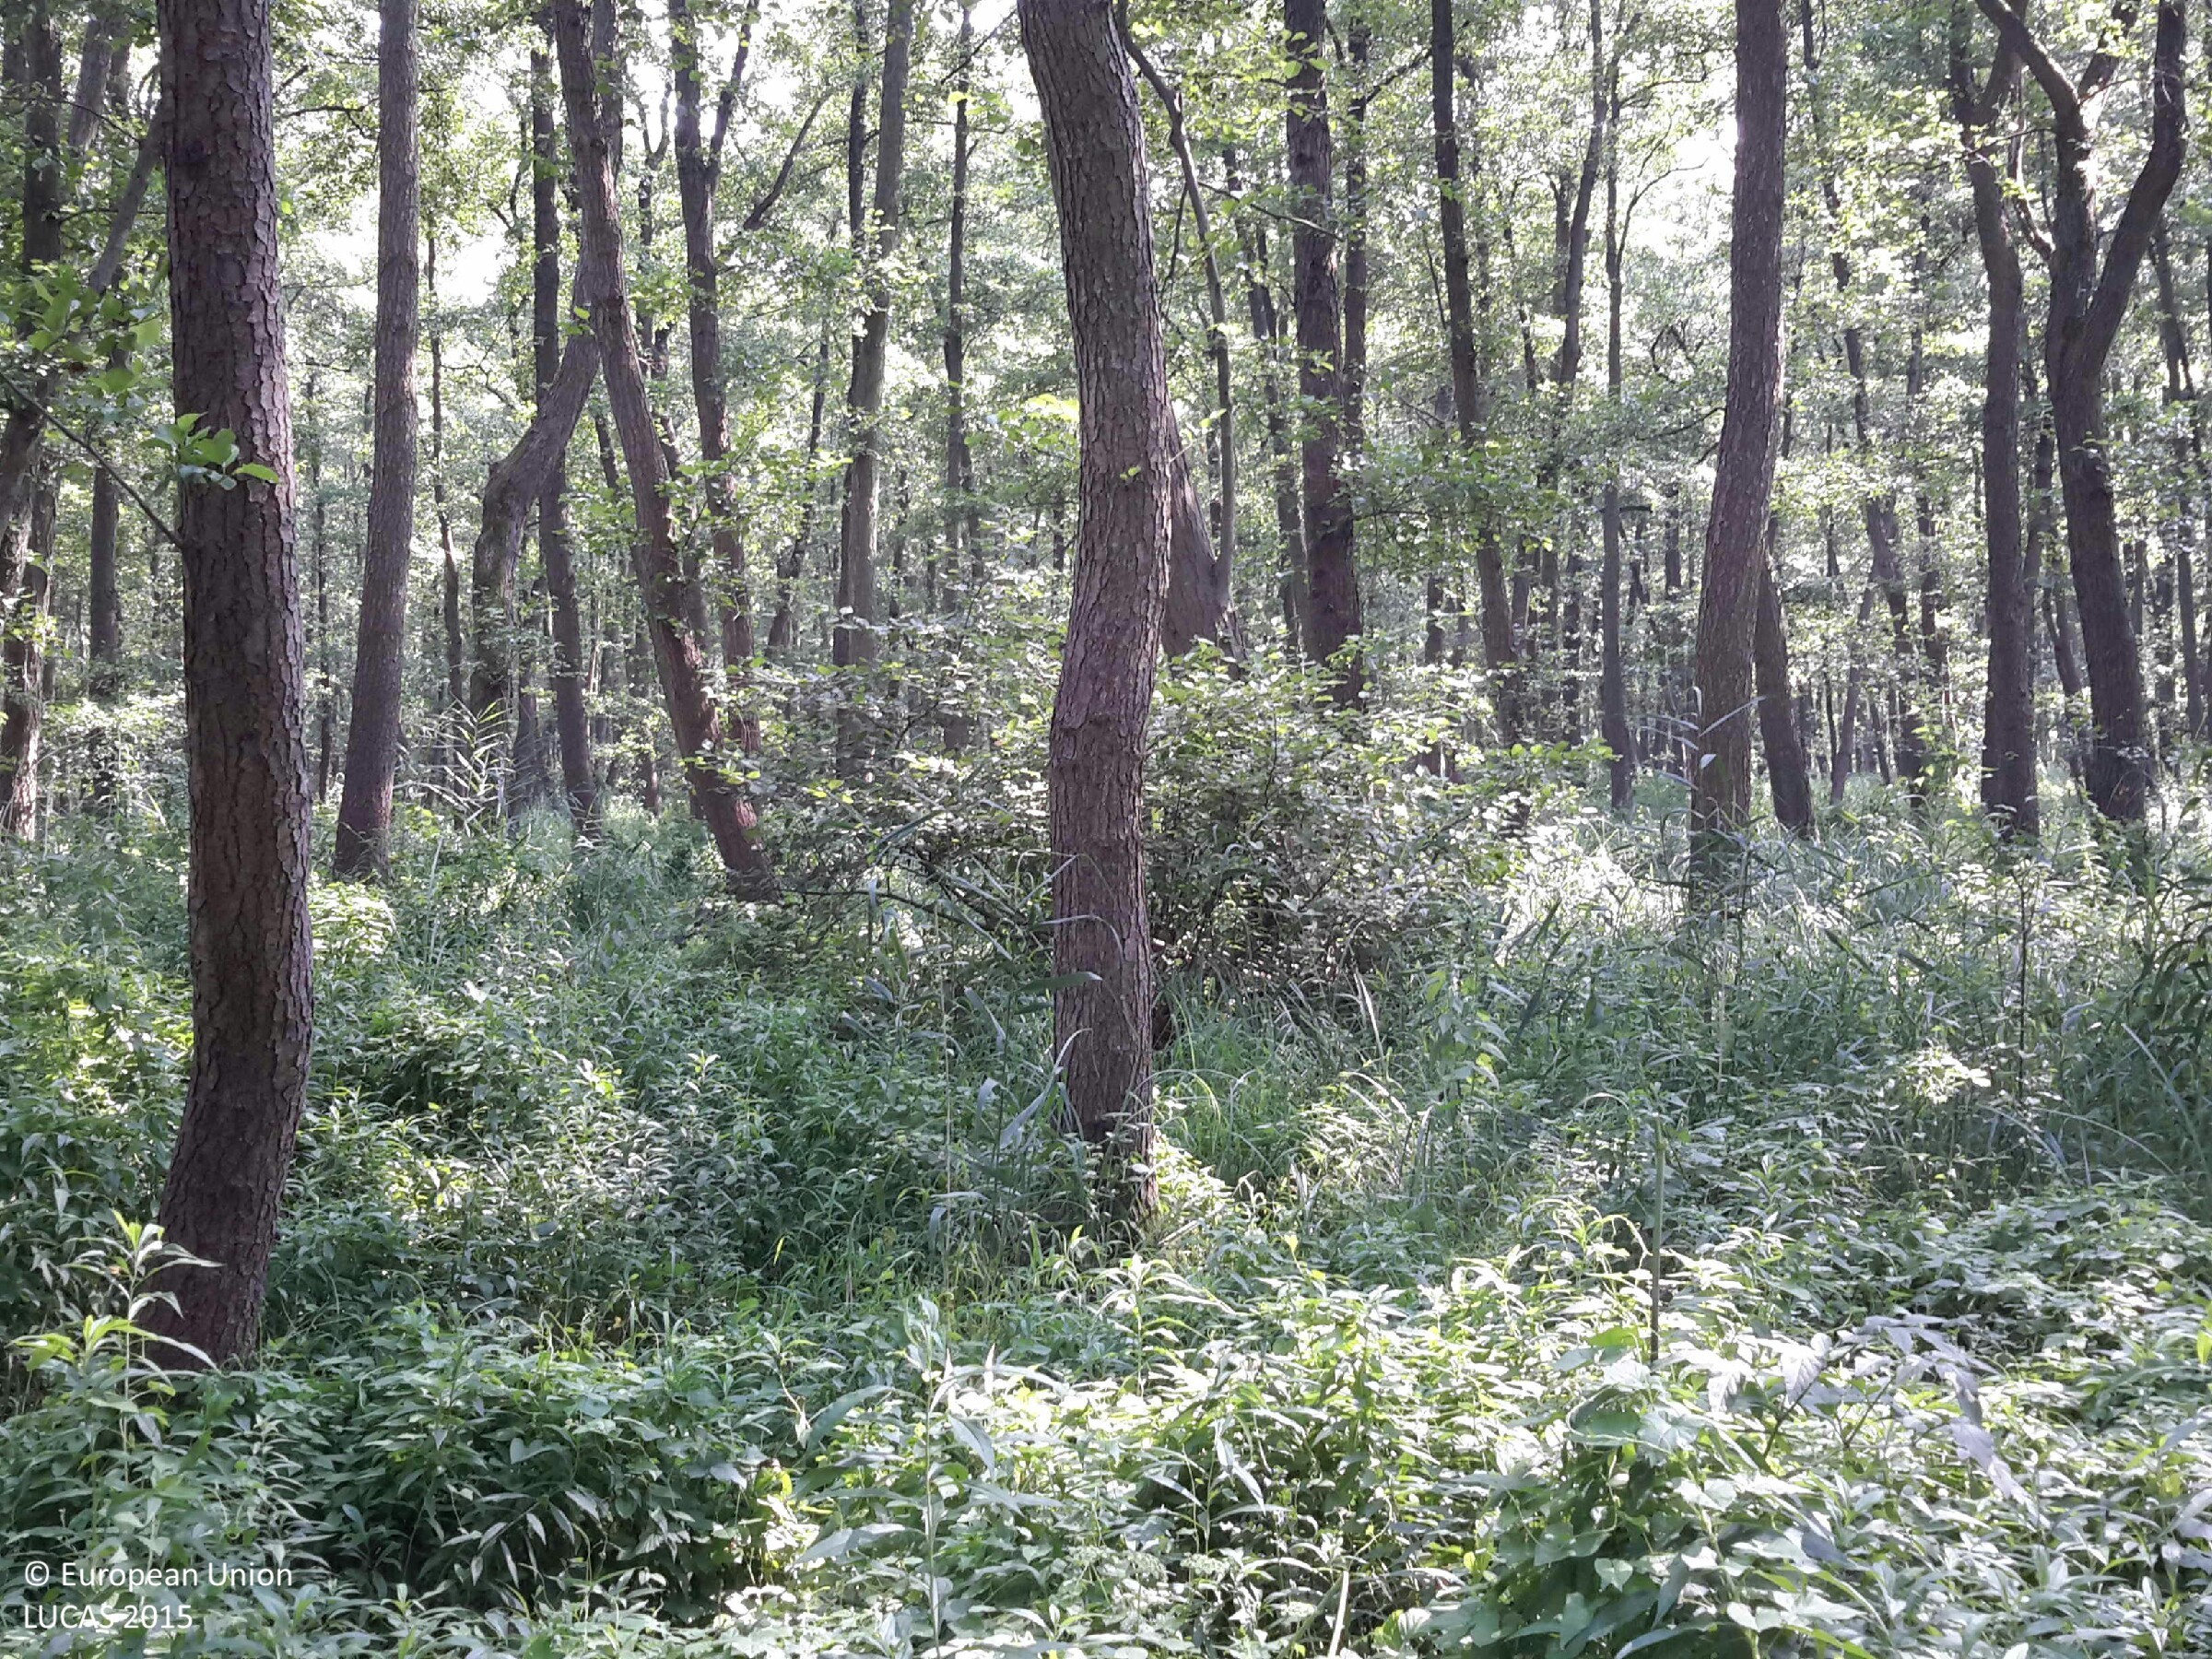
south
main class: Woodland
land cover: Broadleaved woodland
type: mesophytic deciduous forest
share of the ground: > 75 %
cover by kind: broadleaved forest trees 90 %, herbaceous plants 10 %
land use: Forestry
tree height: > 5 m
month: August
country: HU
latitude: 47.7463
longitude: 17.3034
